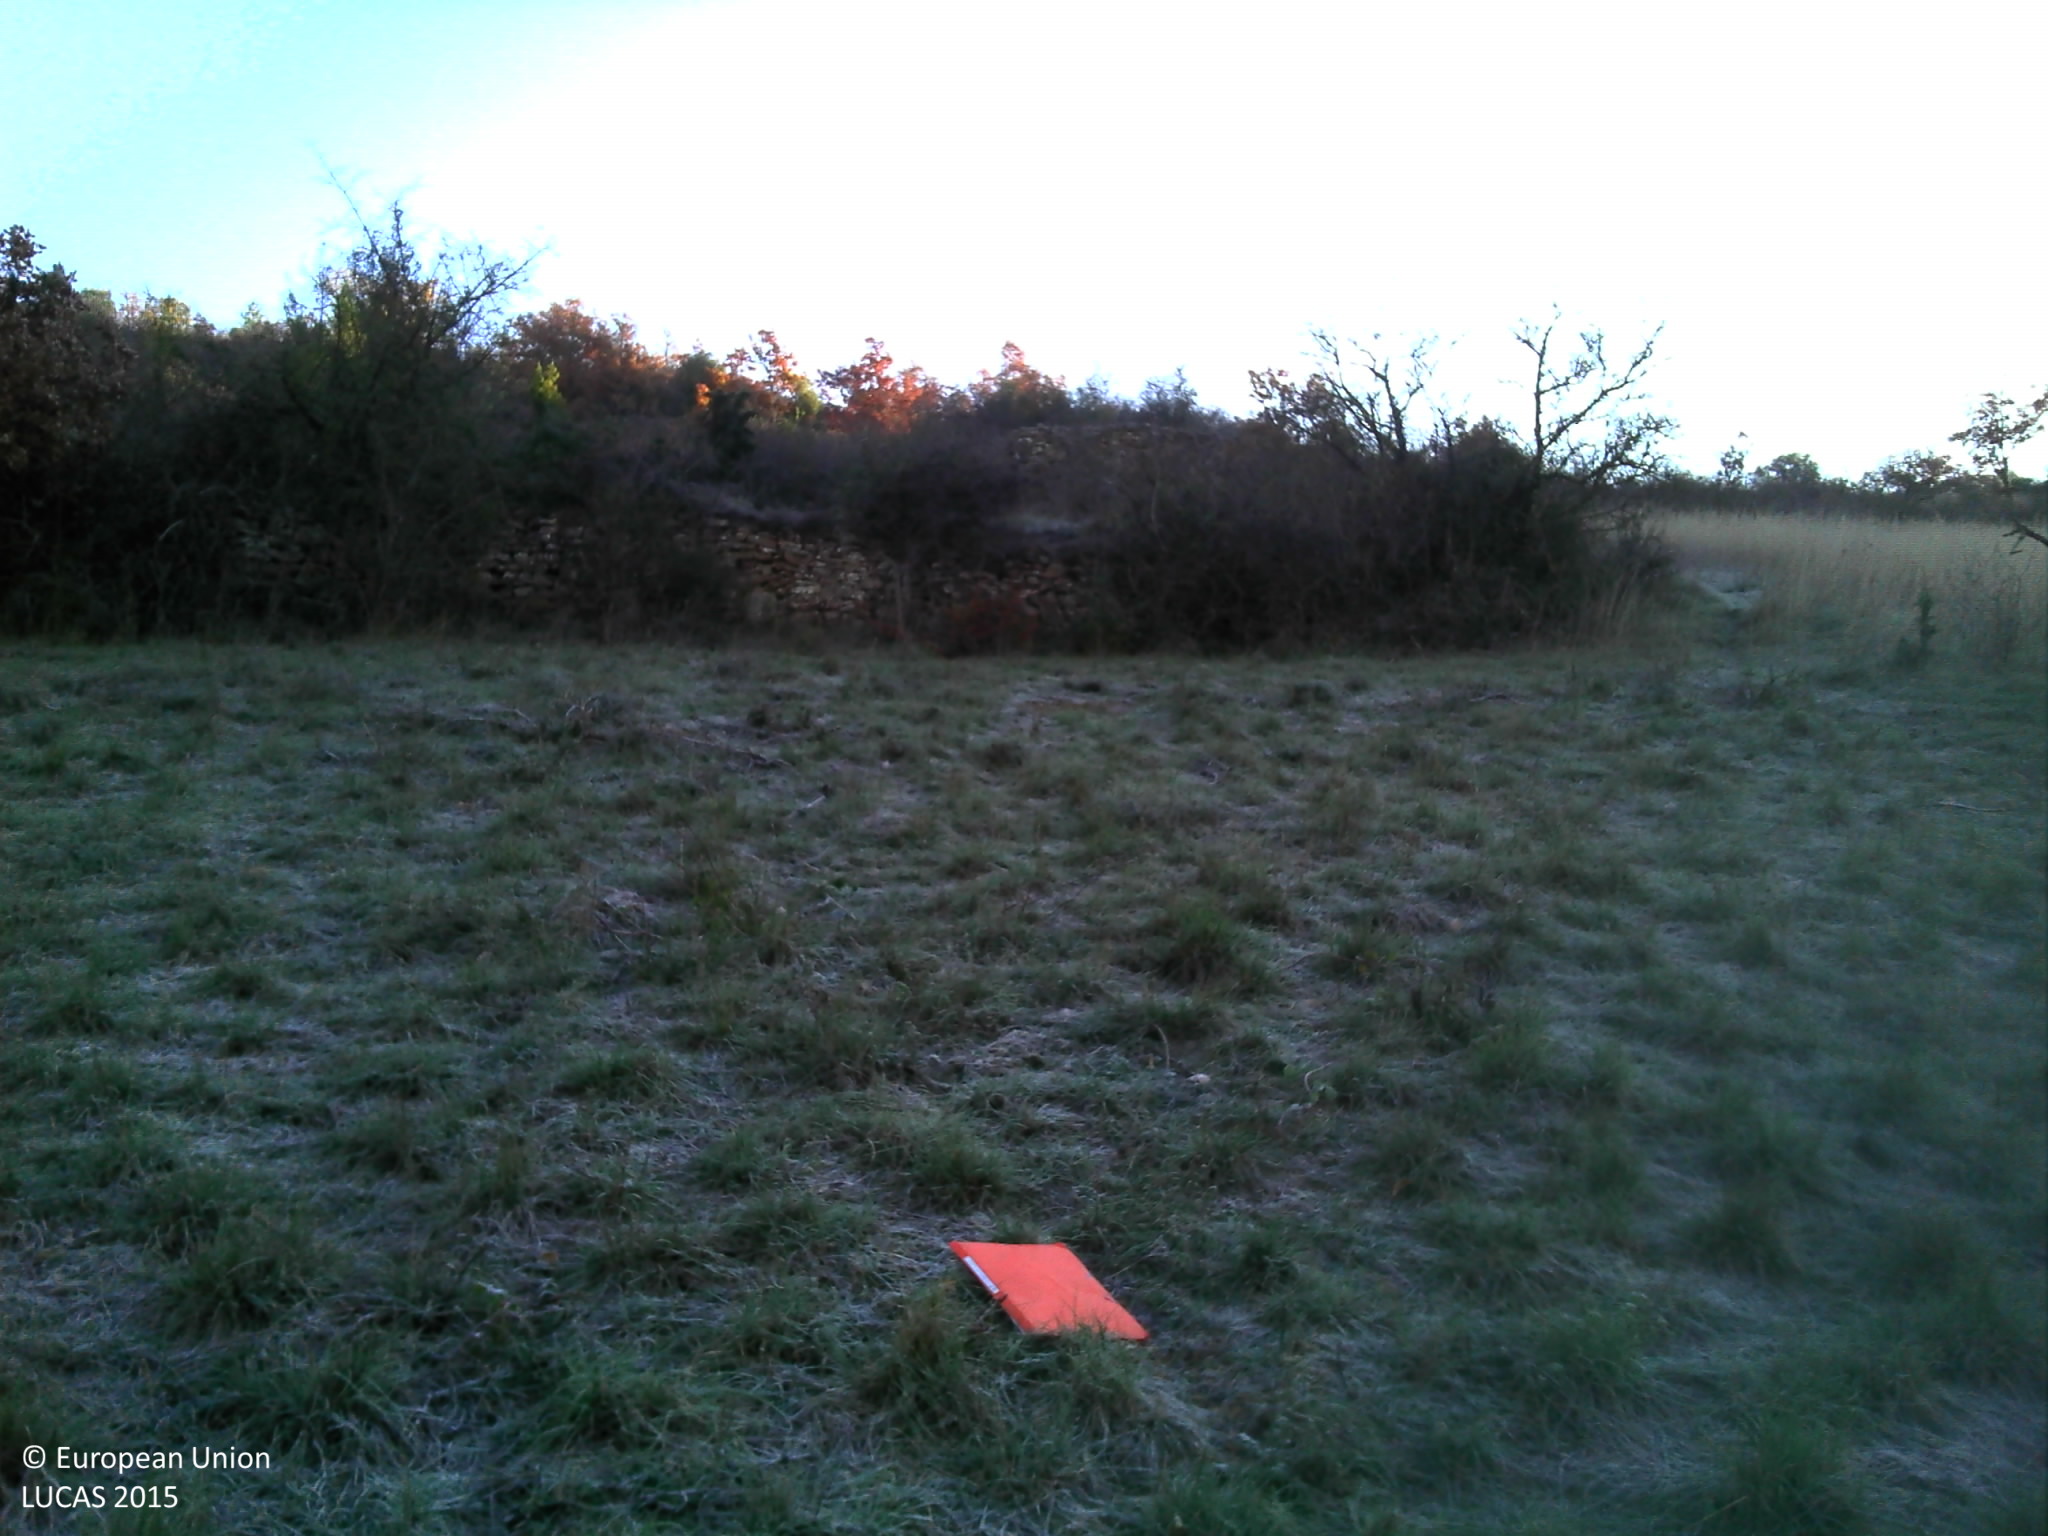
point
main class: Grassland
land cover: Grassland without tree/shrub cover
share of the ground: > 75 %
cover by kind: herbaceous plants 100 %
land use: Agriculture (excluding fallow land and kitchen gardens)
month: November
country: FR
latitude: 44.0958
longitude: 2.9983
